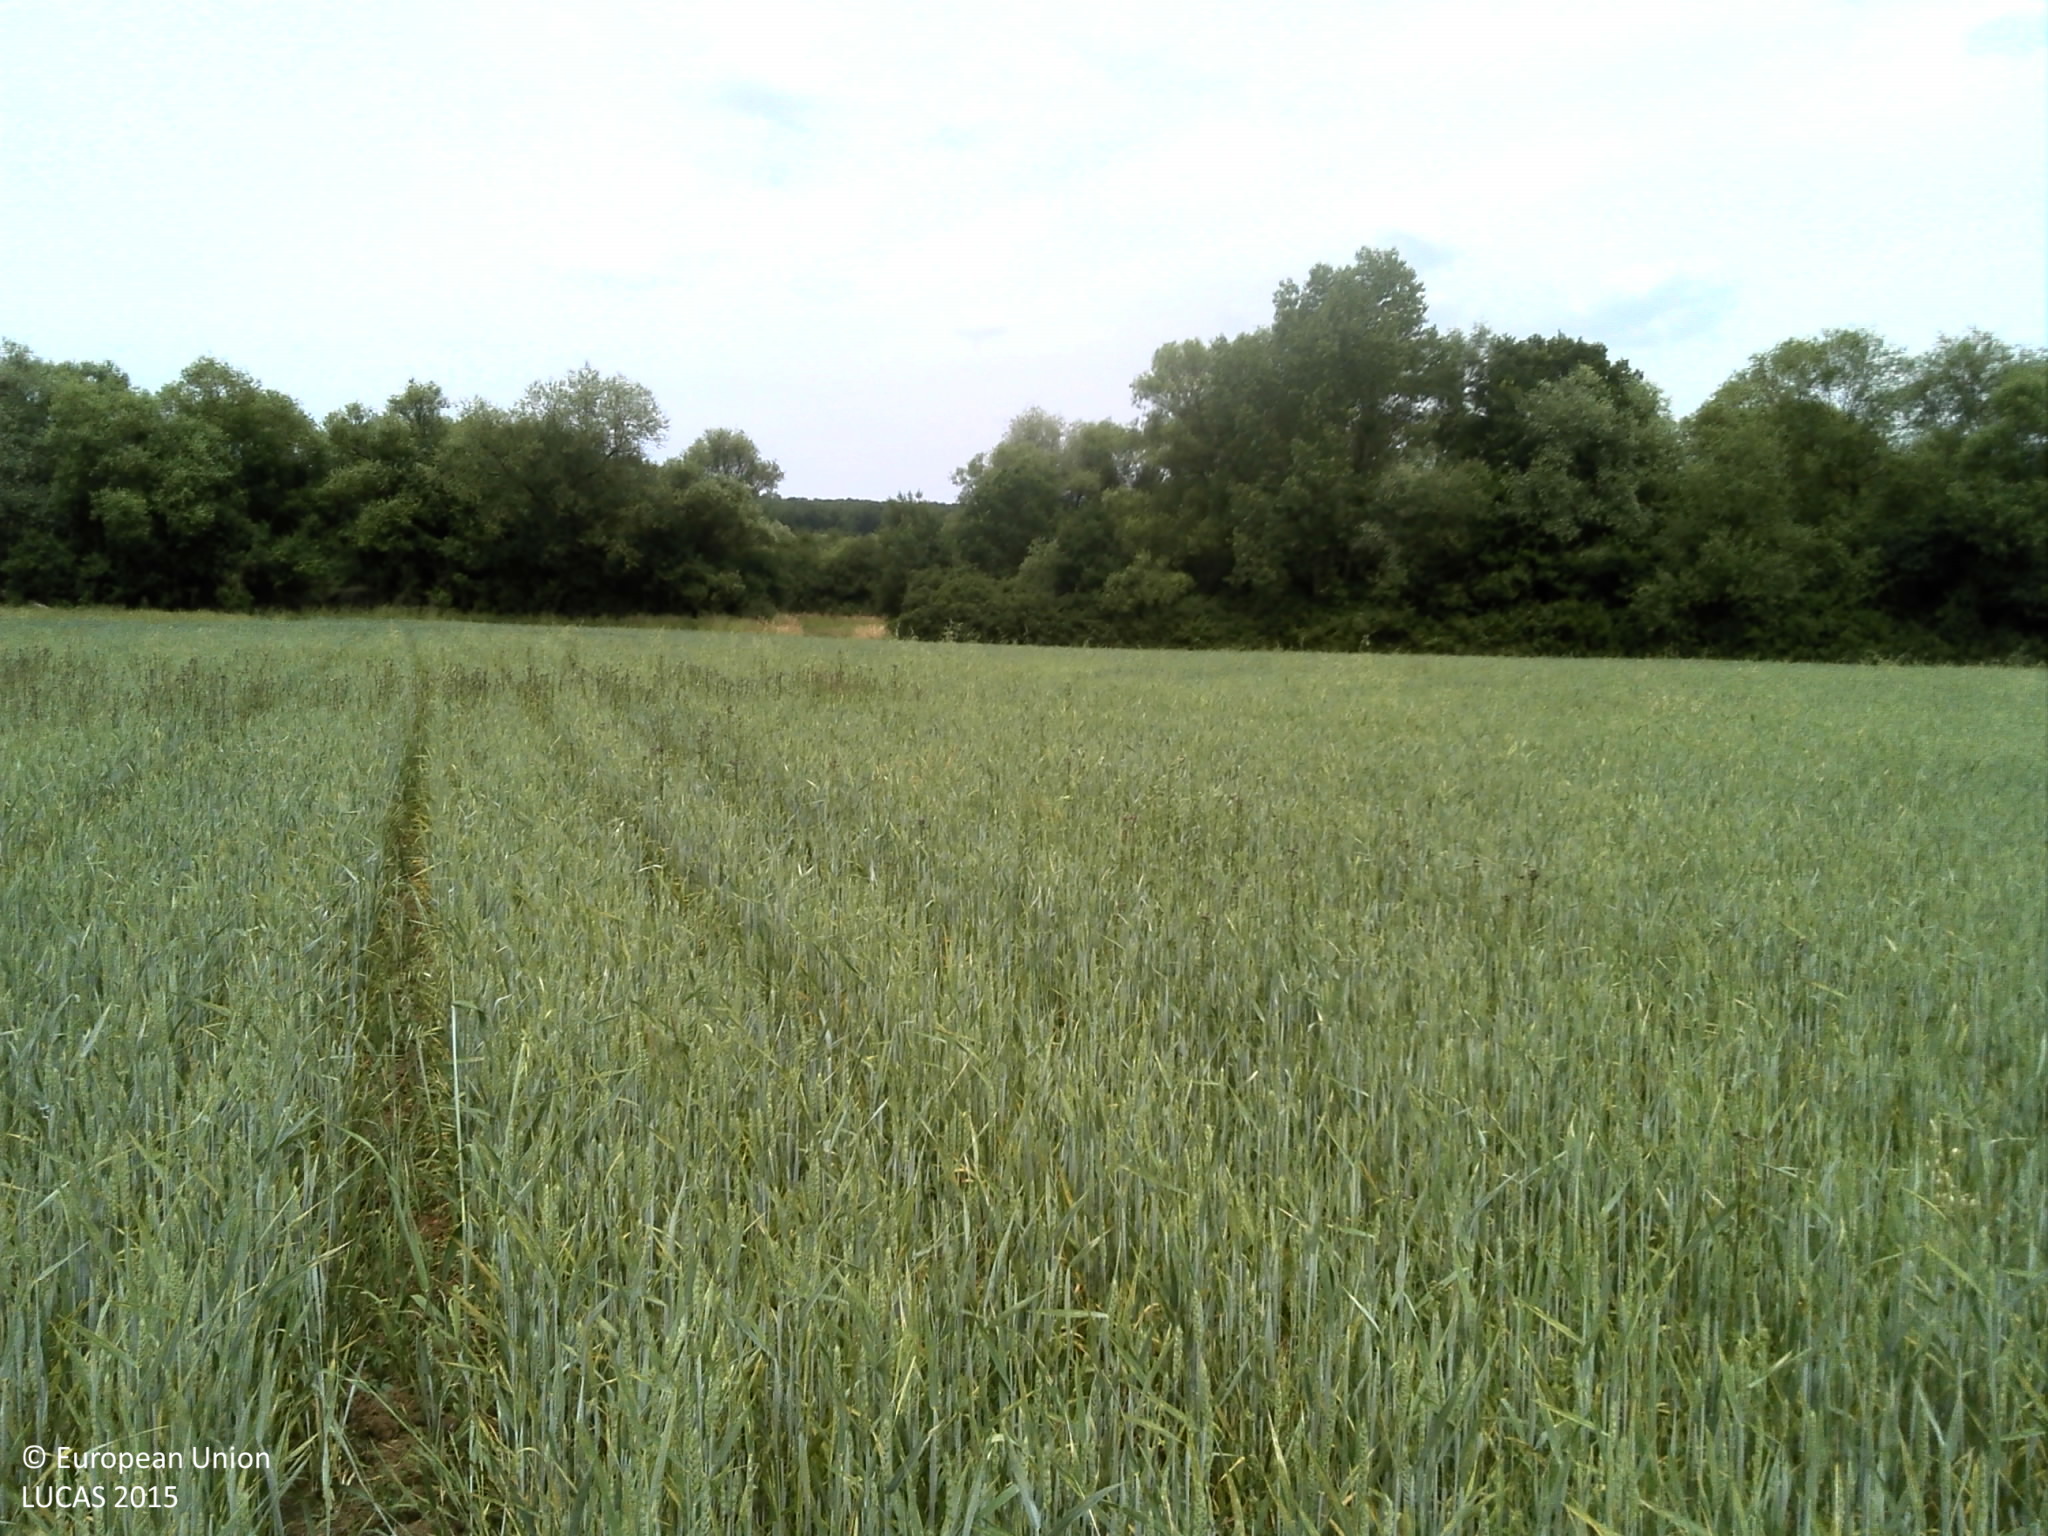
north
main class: Cropland
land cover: Barley
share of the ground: > 75 %
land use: Agriculture (excluding fallow land and kitchen gardens)
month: June
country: FR
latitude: 49.3113
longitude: 6.2170
